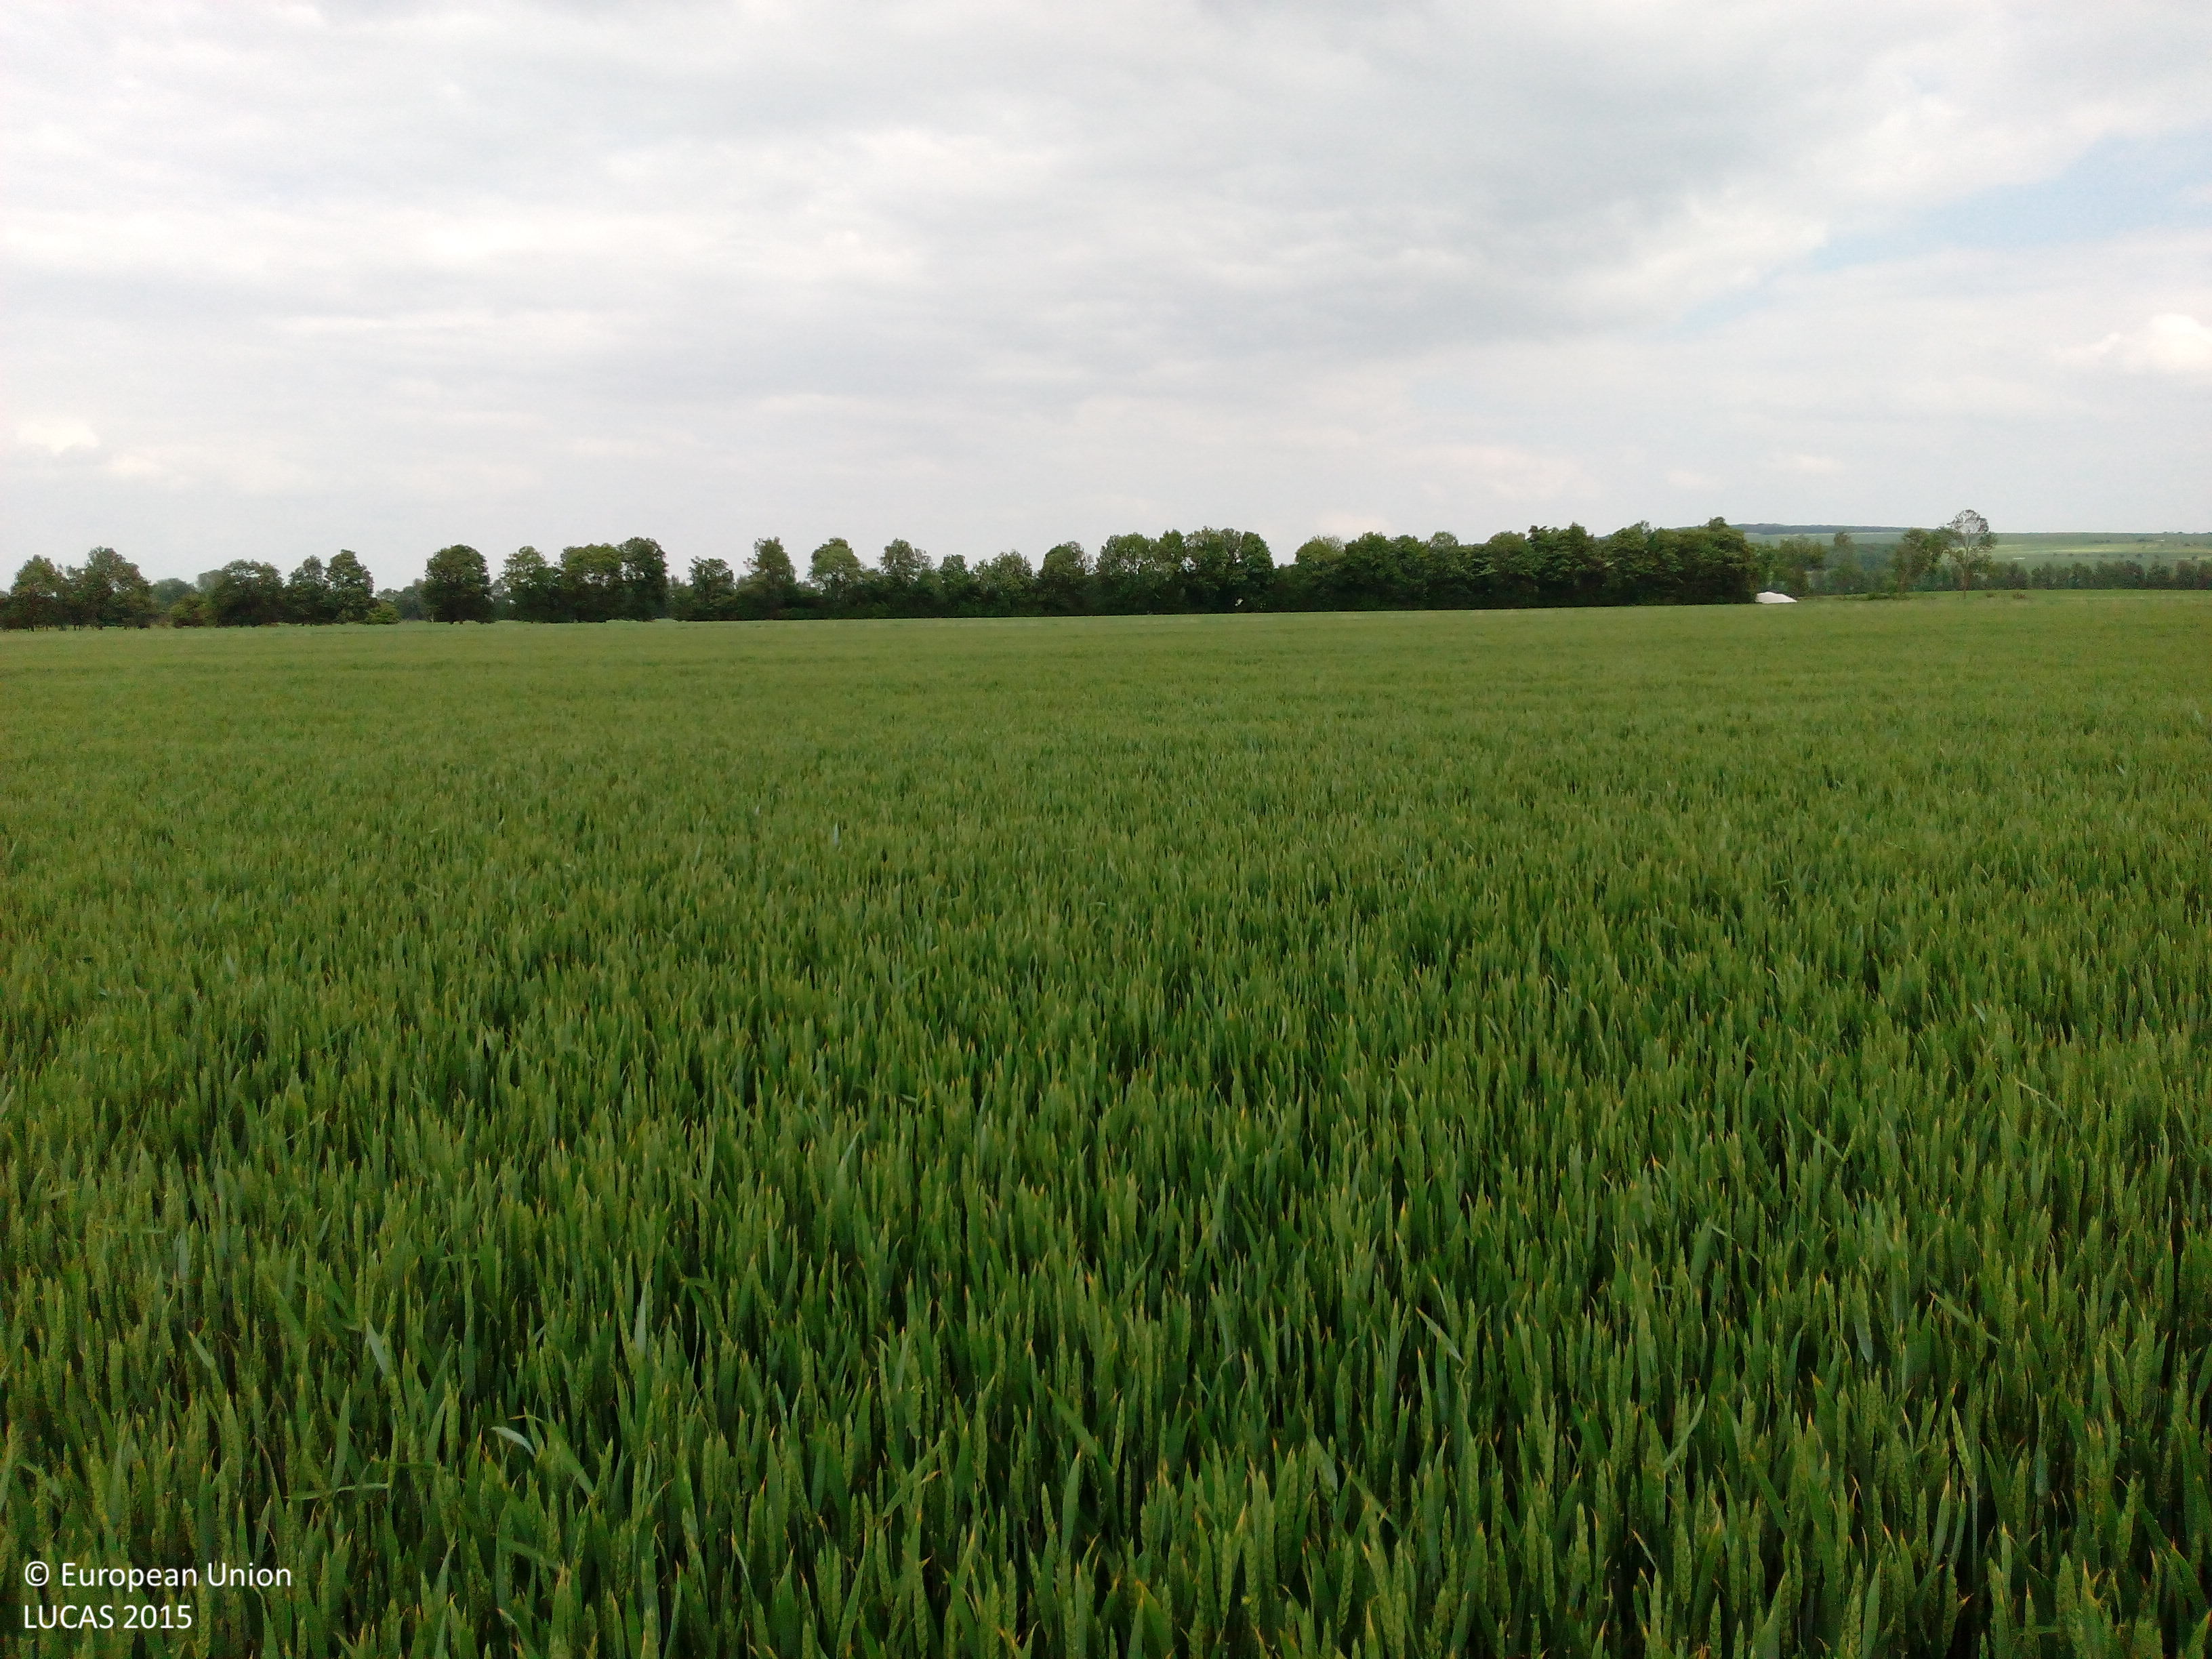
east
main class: Cropland
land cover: Common wheat
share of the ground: > 75 %
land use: Agriculture (excluding fallow land and kitchen gardens)
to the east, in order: Common wheat; Grass margins; Ditches and canals; Grass margins; Common wheat
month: June
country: DE
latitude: 52.0343
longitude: 10.6266
